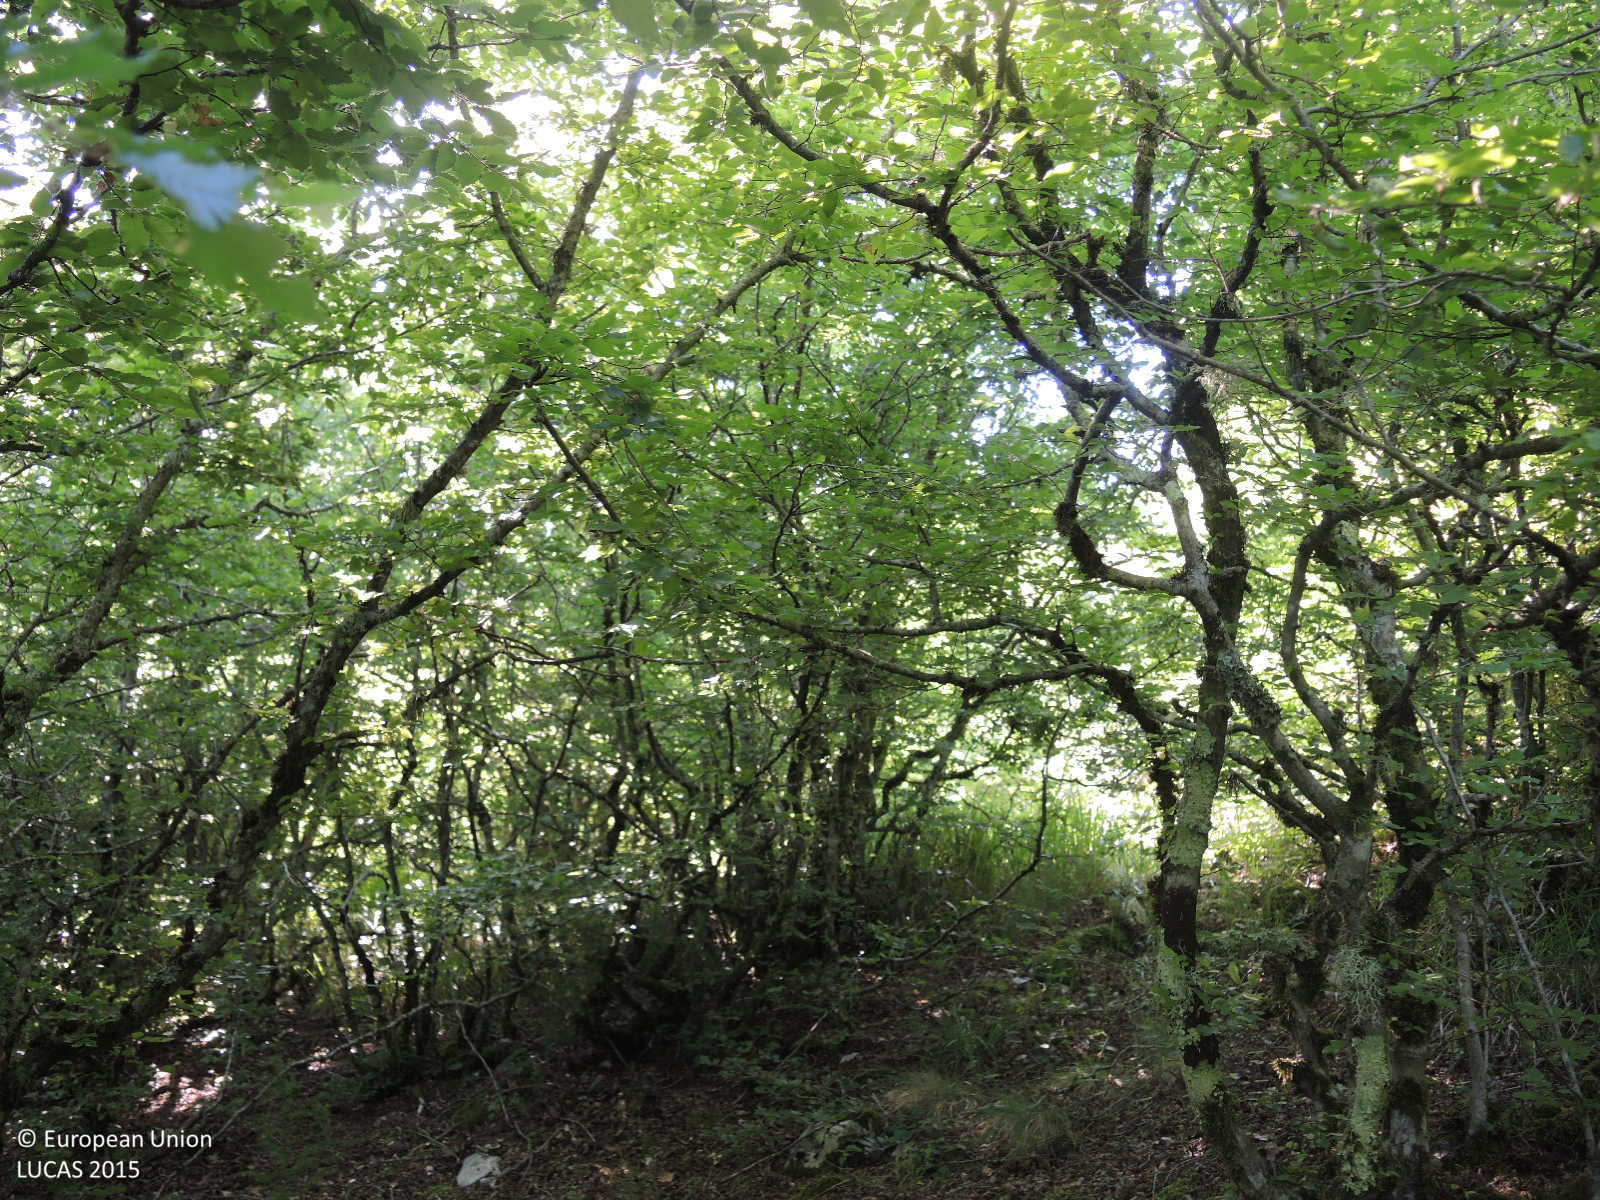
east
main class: Woodland
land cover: Broadleaved woodland
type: thermophilous deciduous forest
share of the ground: > 75 %
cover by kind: broadleaved forest trees 90 %, lichens and mosses 5 %, consolidated bare surface 5 %
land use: Semi-natural and natural areas not in use
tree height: > 5 m
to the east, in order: Broadleaved woodland
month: June
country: HR
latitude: 43.6584
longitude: 16.2035
